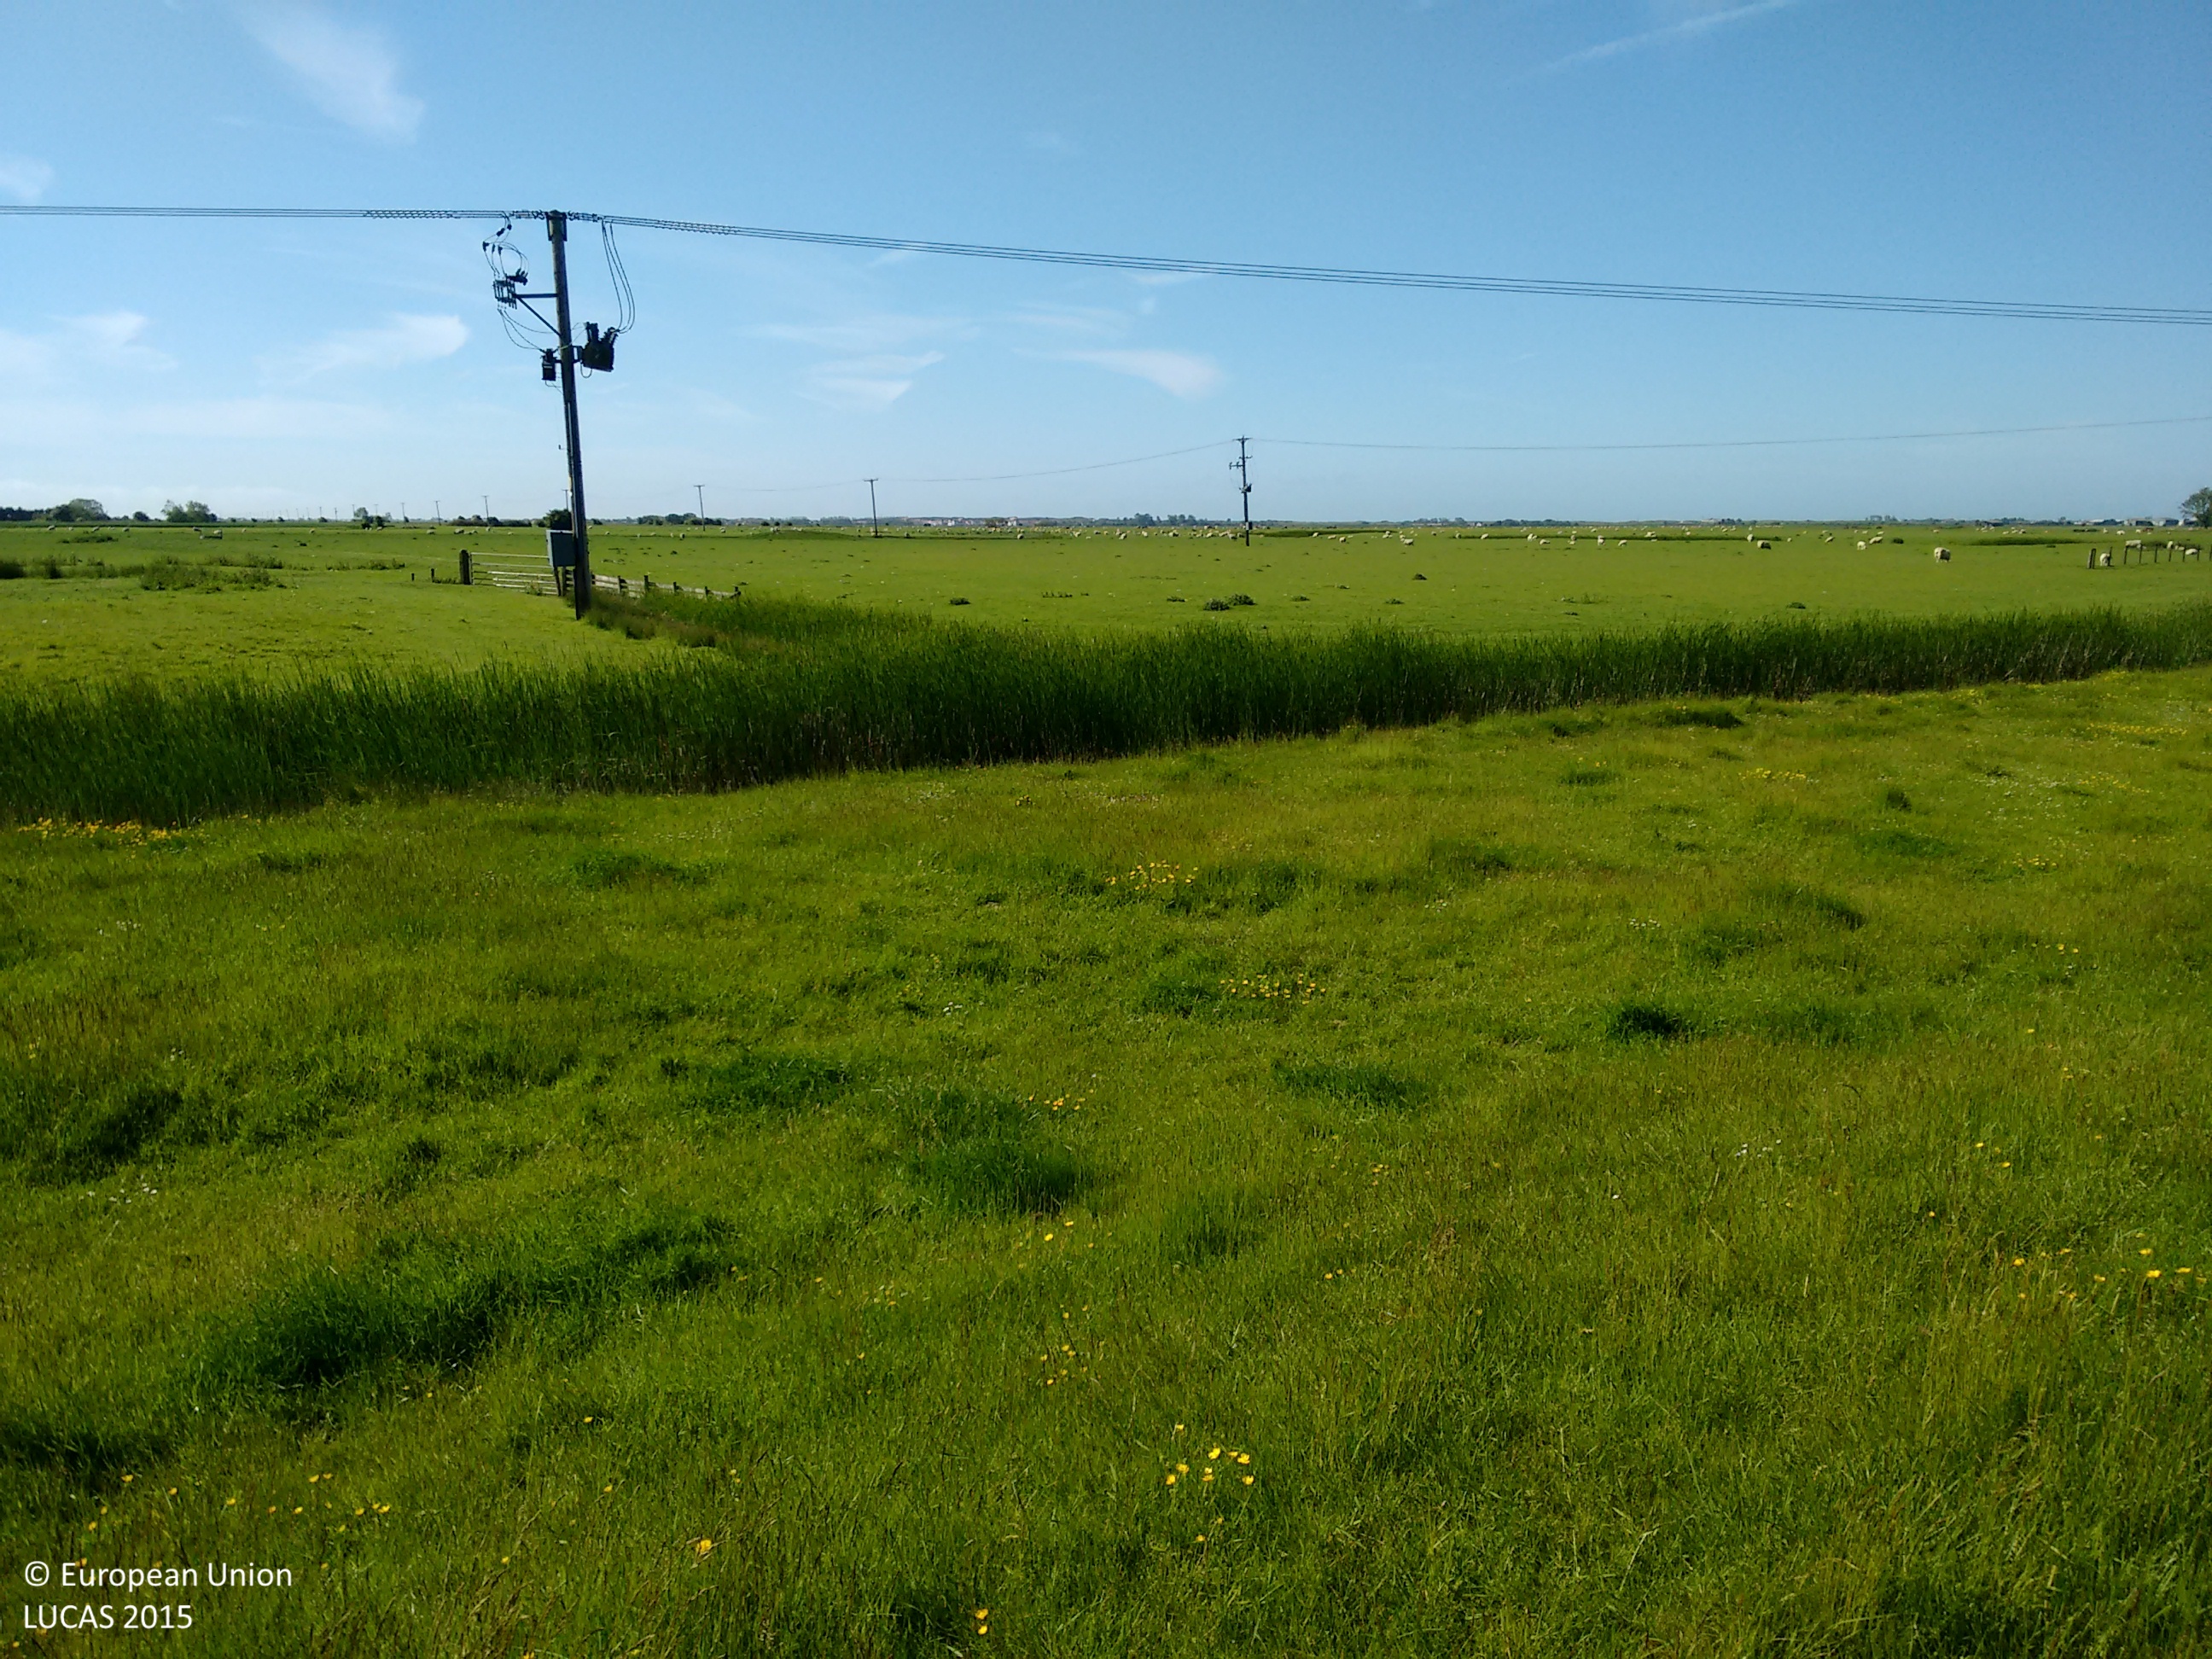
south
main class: Grassland
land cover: Grassland without tree/shrub cover
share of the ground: > 75 %
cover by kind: herbaceous plants 100 %
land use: Agriculture (excluding fallow land and kitchen gardens)
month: June
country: GB
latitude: 50.9691
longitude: 0.7899
